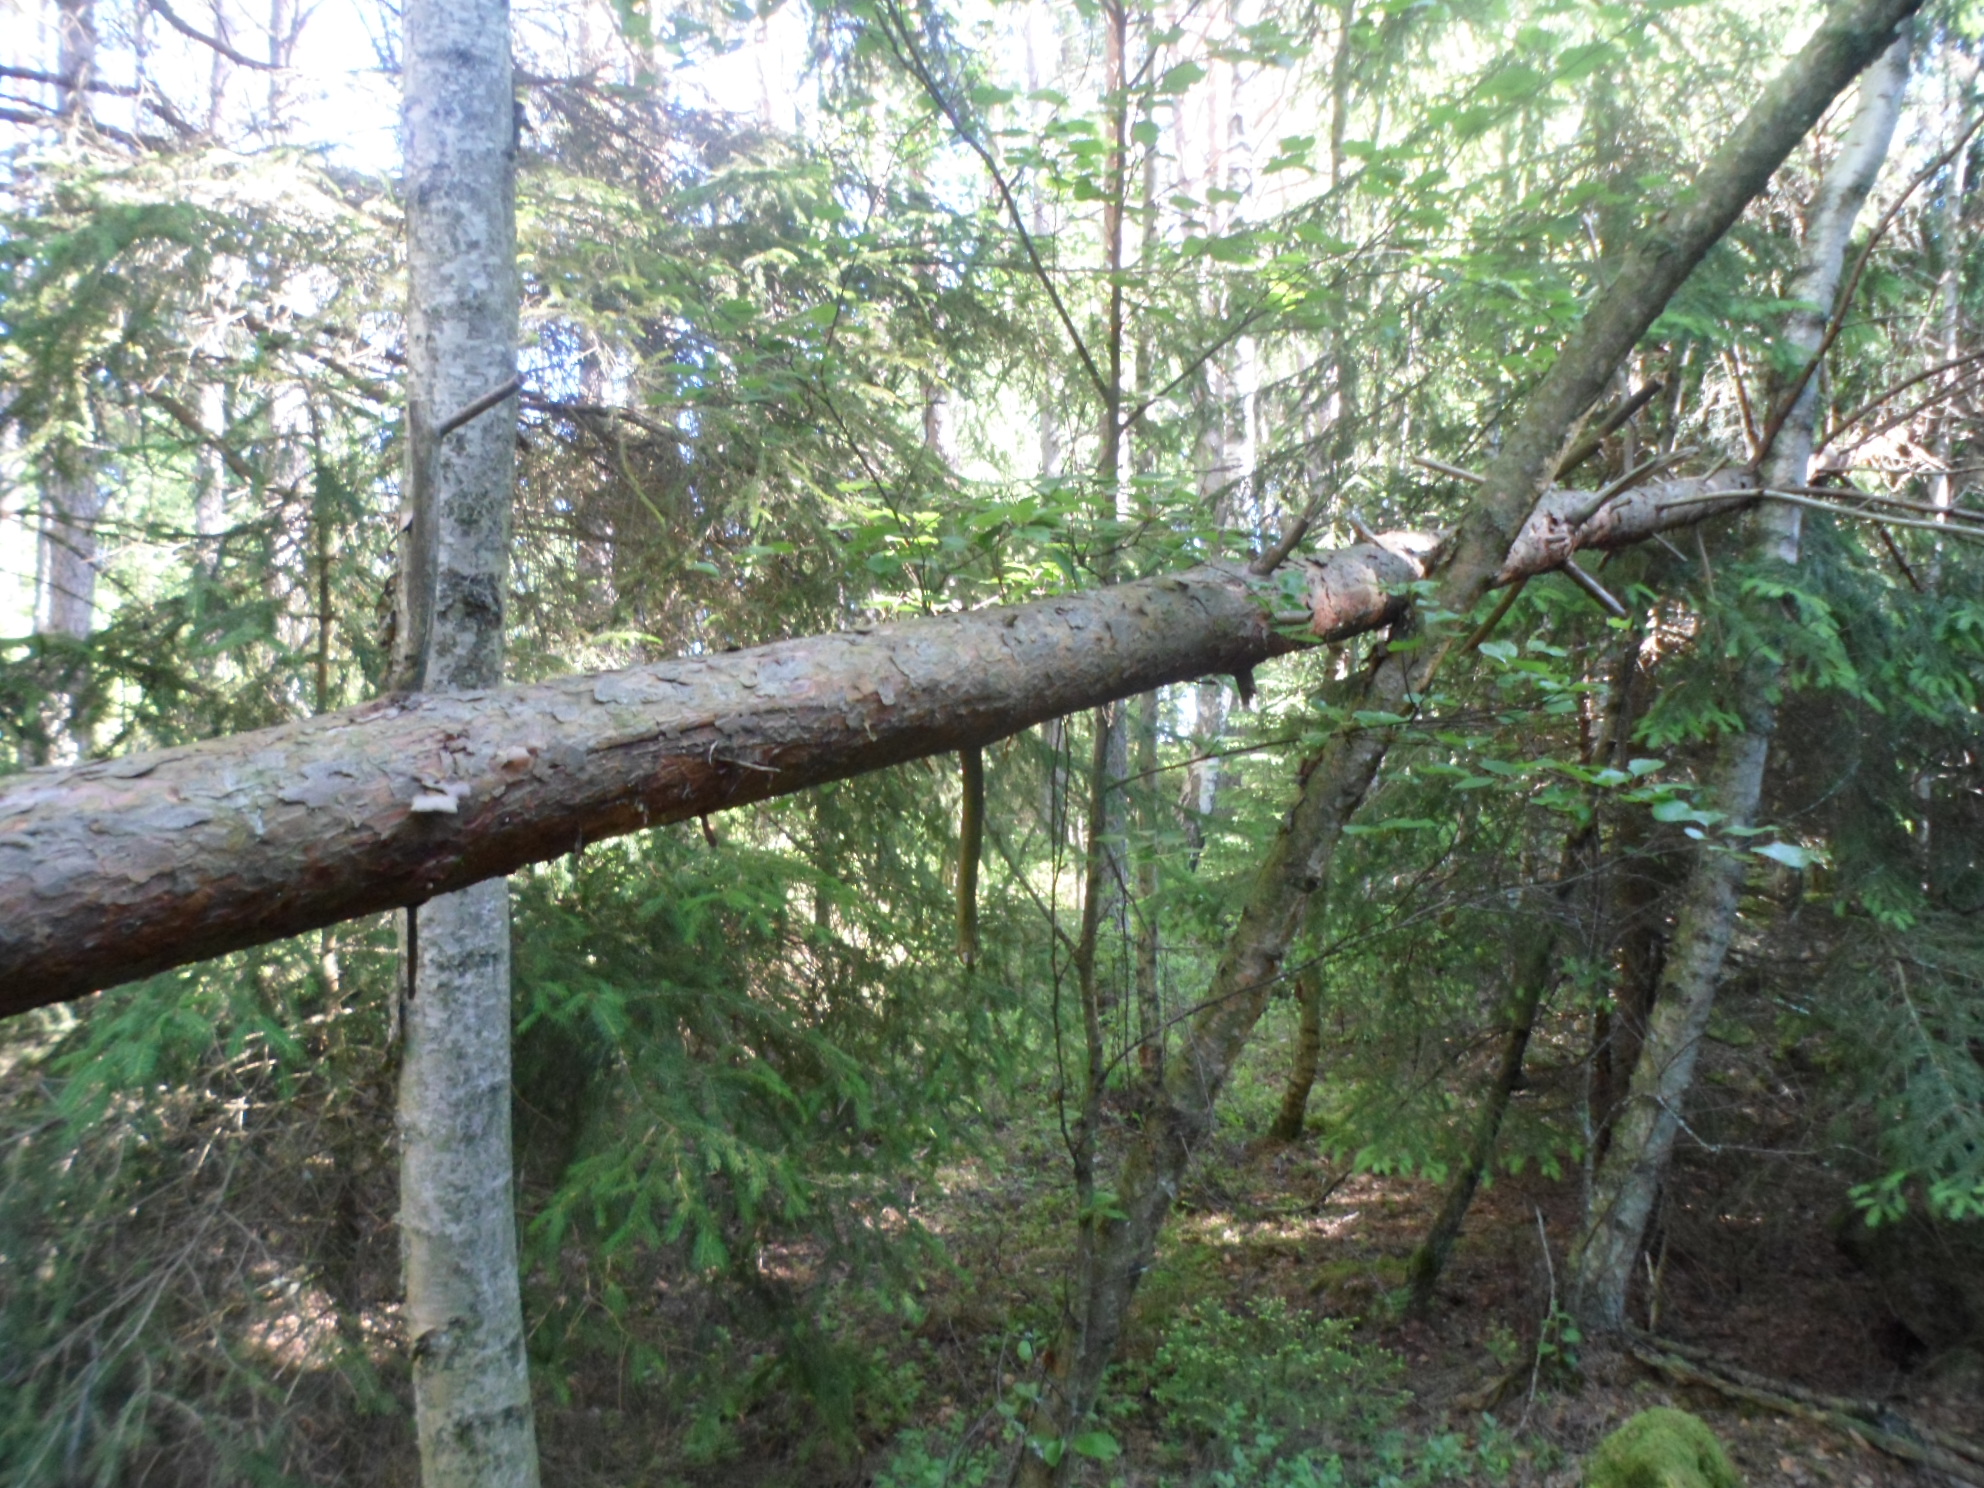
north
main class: Woodland
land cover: Spruce dominated mixed woodland
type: boreal forest
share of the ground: 50 - 75 %
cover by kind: coniferous forest trees 40 %, broadleaved forest trees 20 %, shrubs 20 %, herbaceous plants 10 %, lichens and mosses 10 %
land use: Forestry
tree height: > 5 m
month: July
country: SE
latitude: 57.2989
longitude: 14.4604
